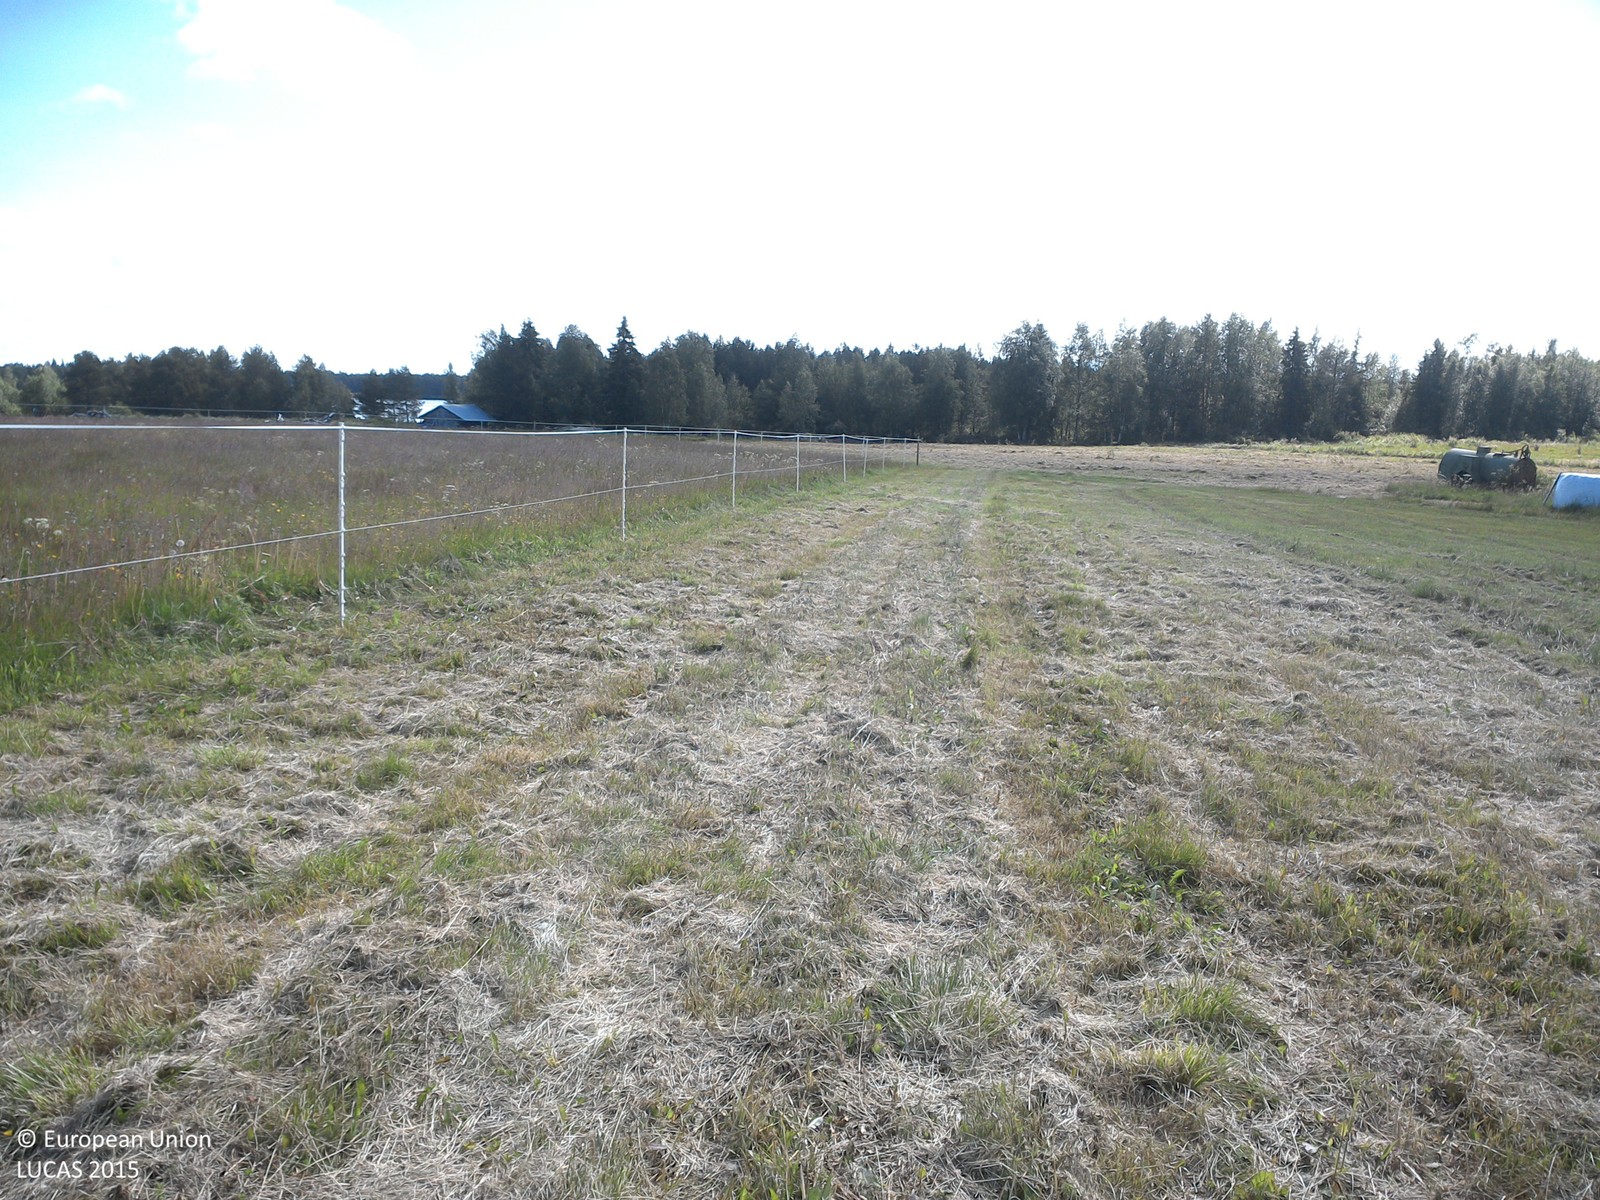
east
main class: Grassland
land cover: Grassland without tree/shrub cover
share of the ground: > 75 %
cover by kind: herbaceous plants 100 %
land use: Agriculture (excluding fallow land and kitchen gardens)
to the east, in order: Grassland without tree/shrub cover; Fences; Grassland without tree/shrub cover; Fences; Grassland without tree/shrub cover; Other bare soil; Other mixed woodland; Shrubland with sparse tree cover; Inland marshes; Inland fresh running water; Inland marshes
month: July
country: SE
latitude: 67.1780
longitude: 22.6478
